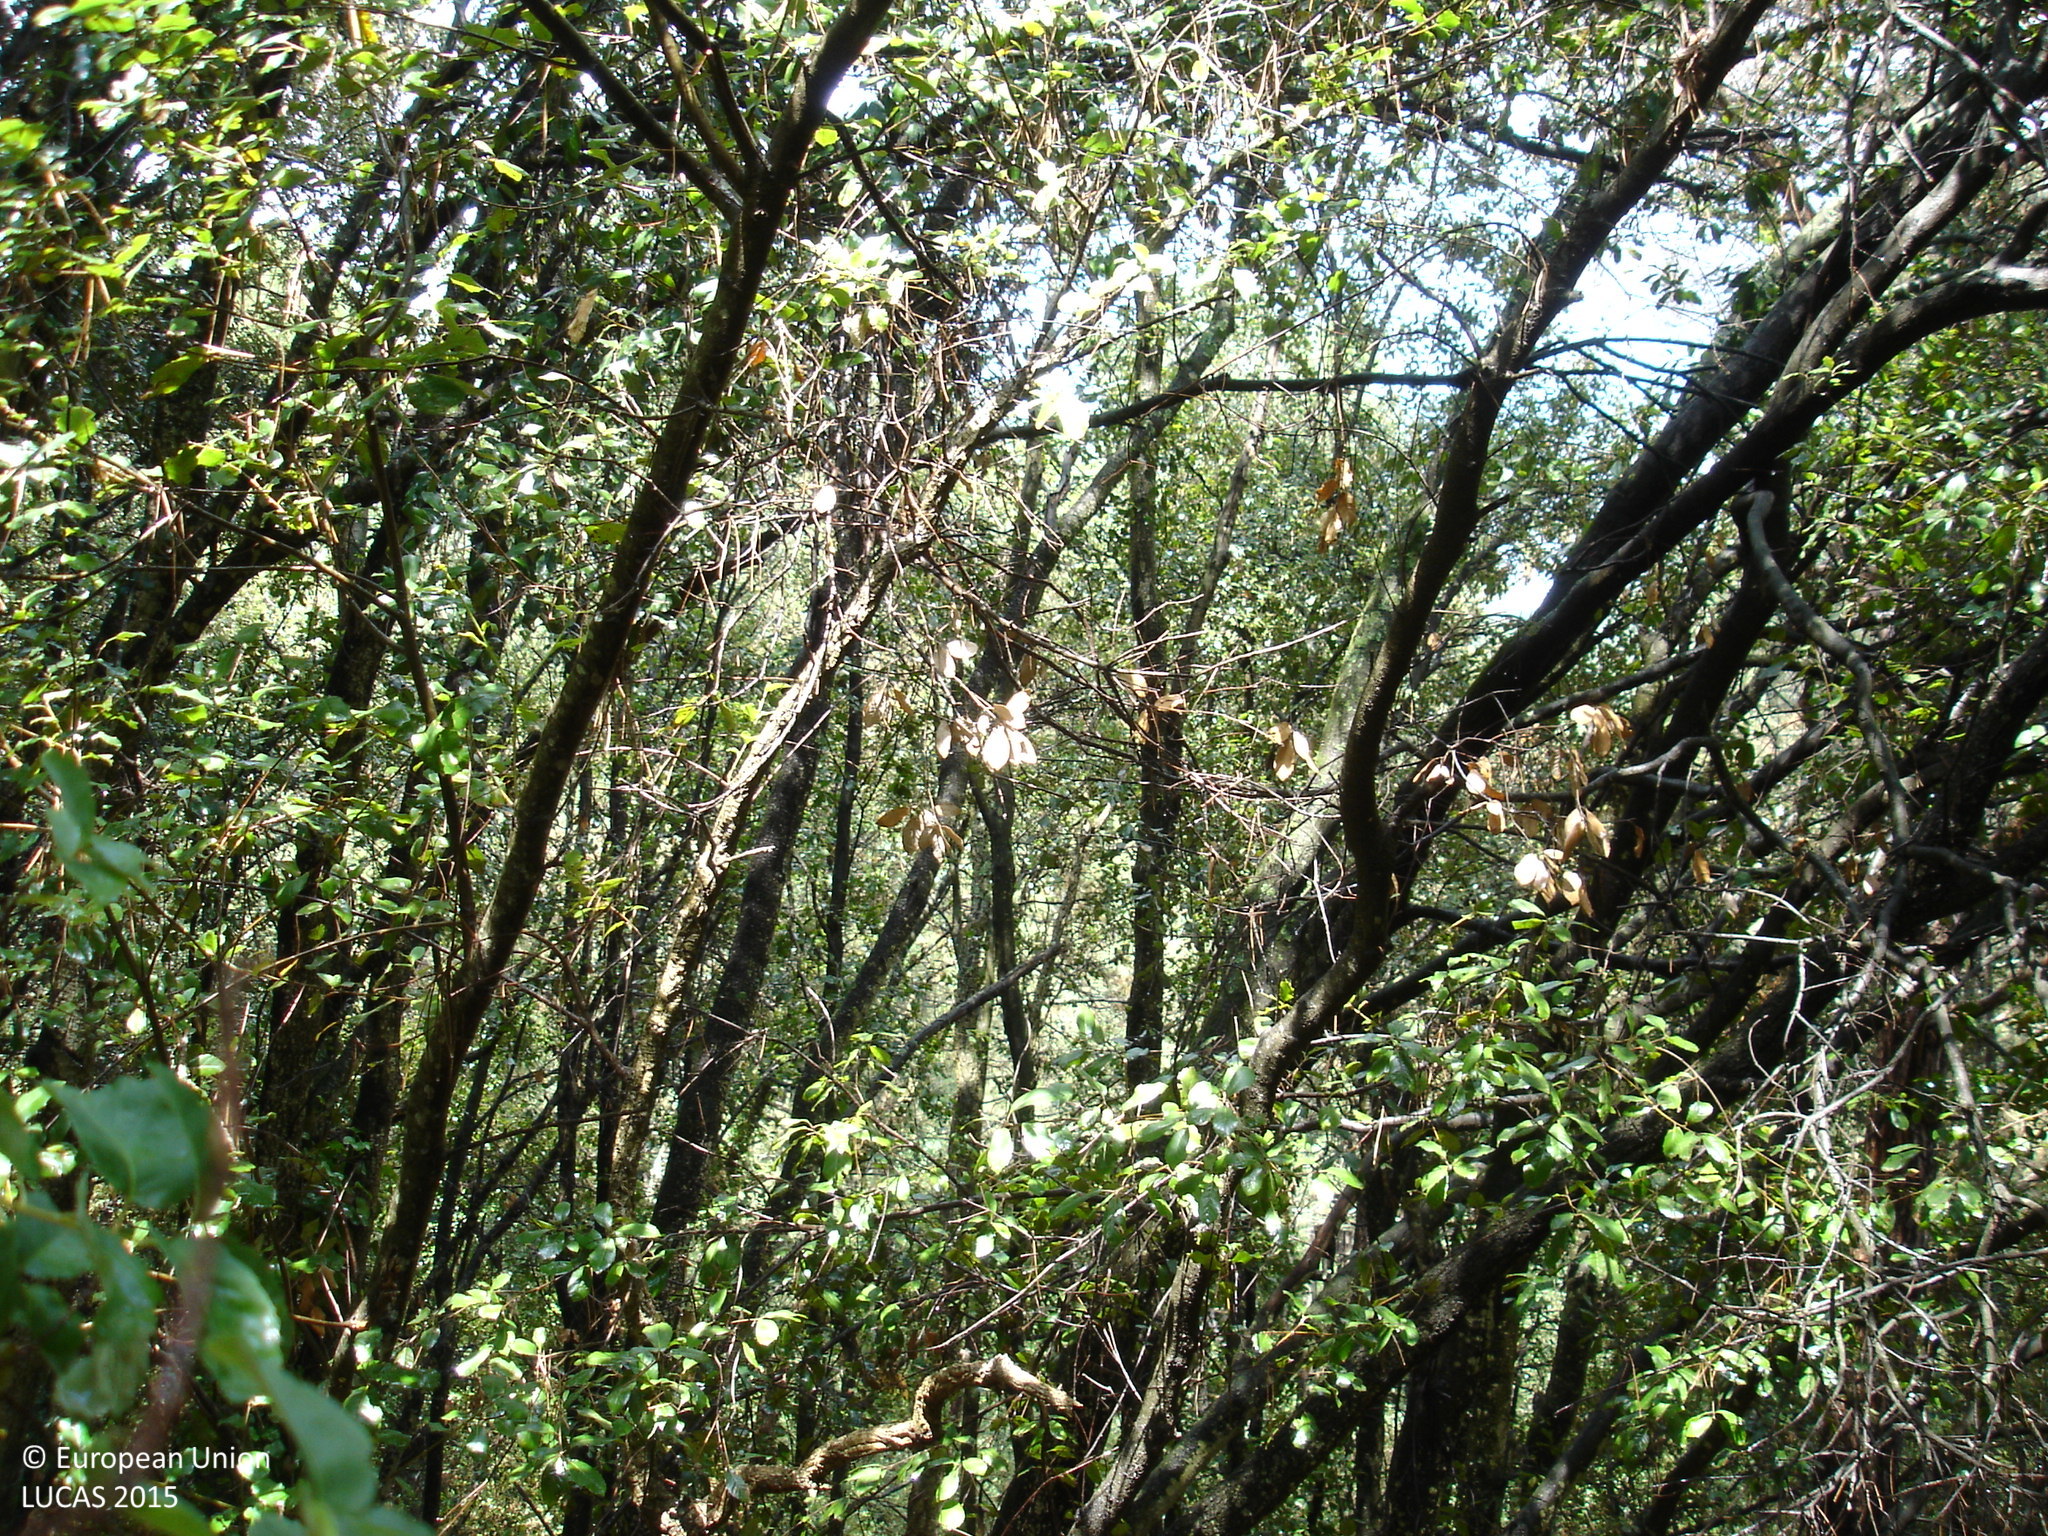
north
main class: Woodland
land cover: Other mixed woodland
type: thermophilous deciduous forest
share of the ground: > 75 %
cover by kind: broadleaved forest trees 75 %, coniferous forest trees 25 %
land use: Forestry
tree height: > 5 m
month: June
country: ES
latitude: 41.8183
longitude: 2.5642
